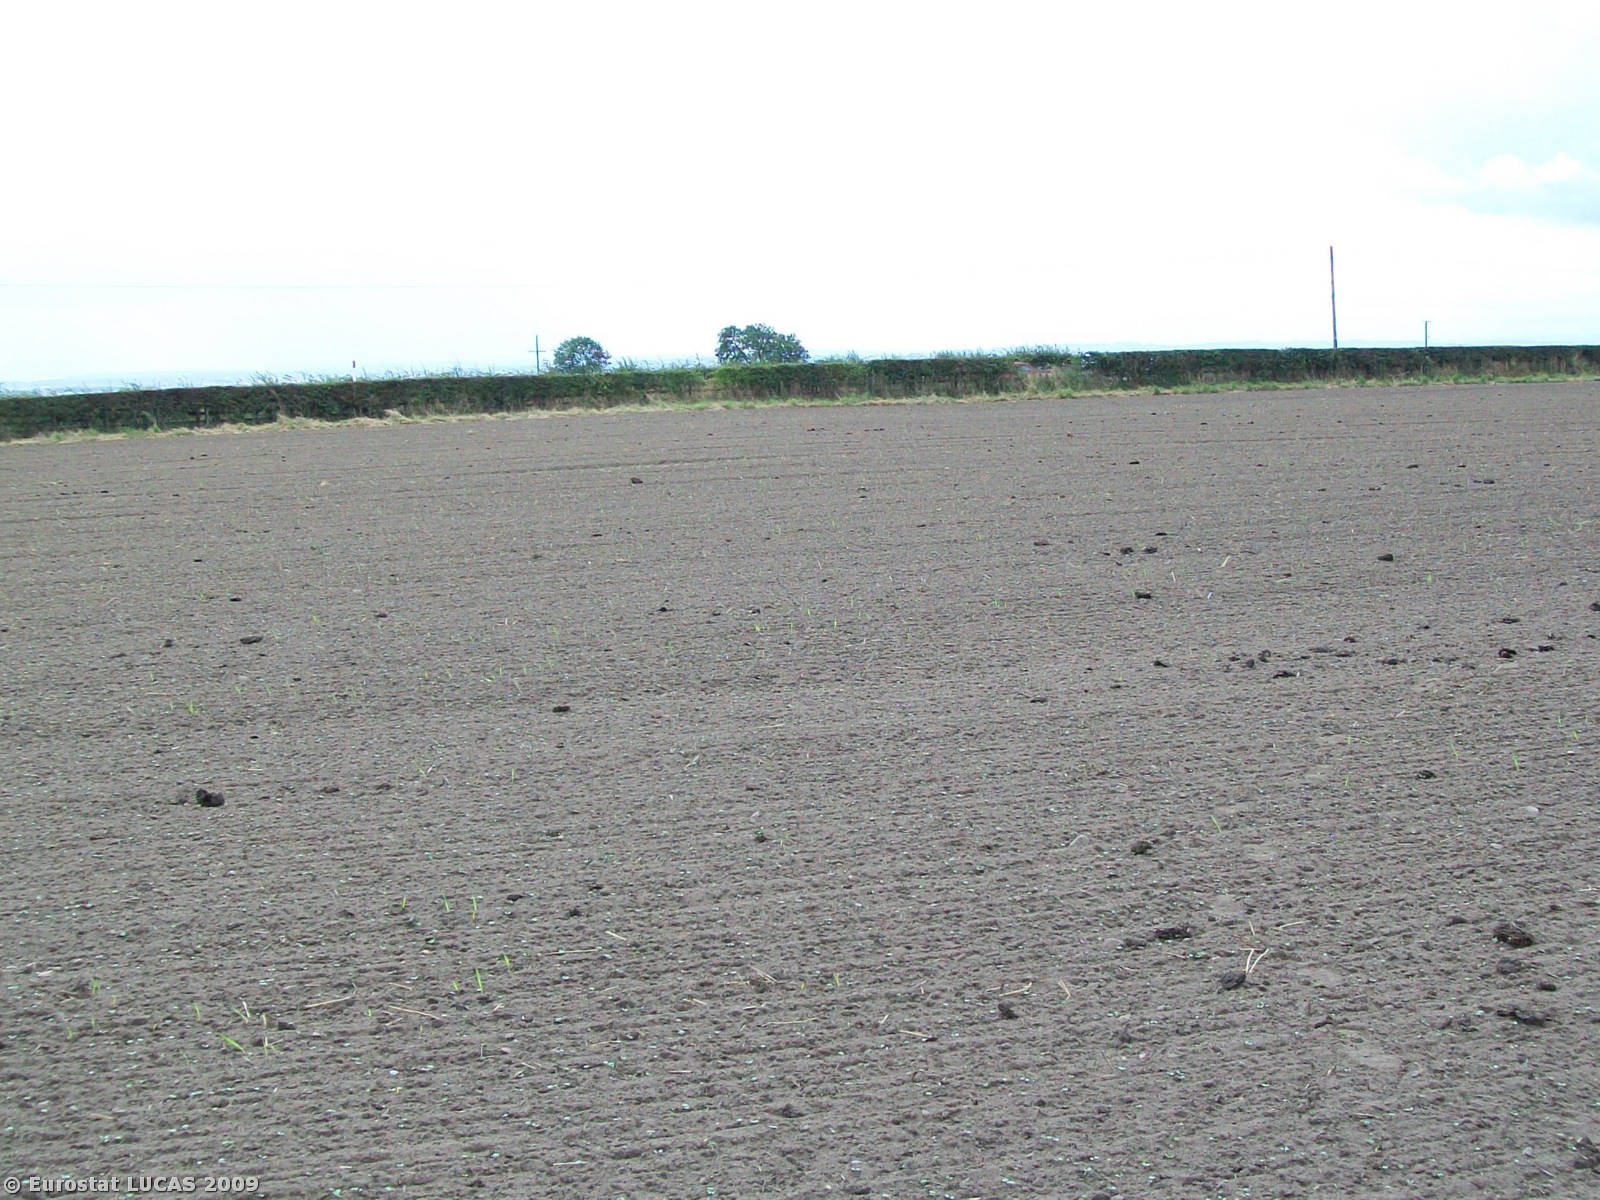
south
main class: Cropland
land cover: Rape and turnip rape
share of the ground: < 10 %
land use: Agriculture (excluding fallow land and kitchen gardens)
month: August
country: GB
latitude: 55.1348
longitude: -1.7679
